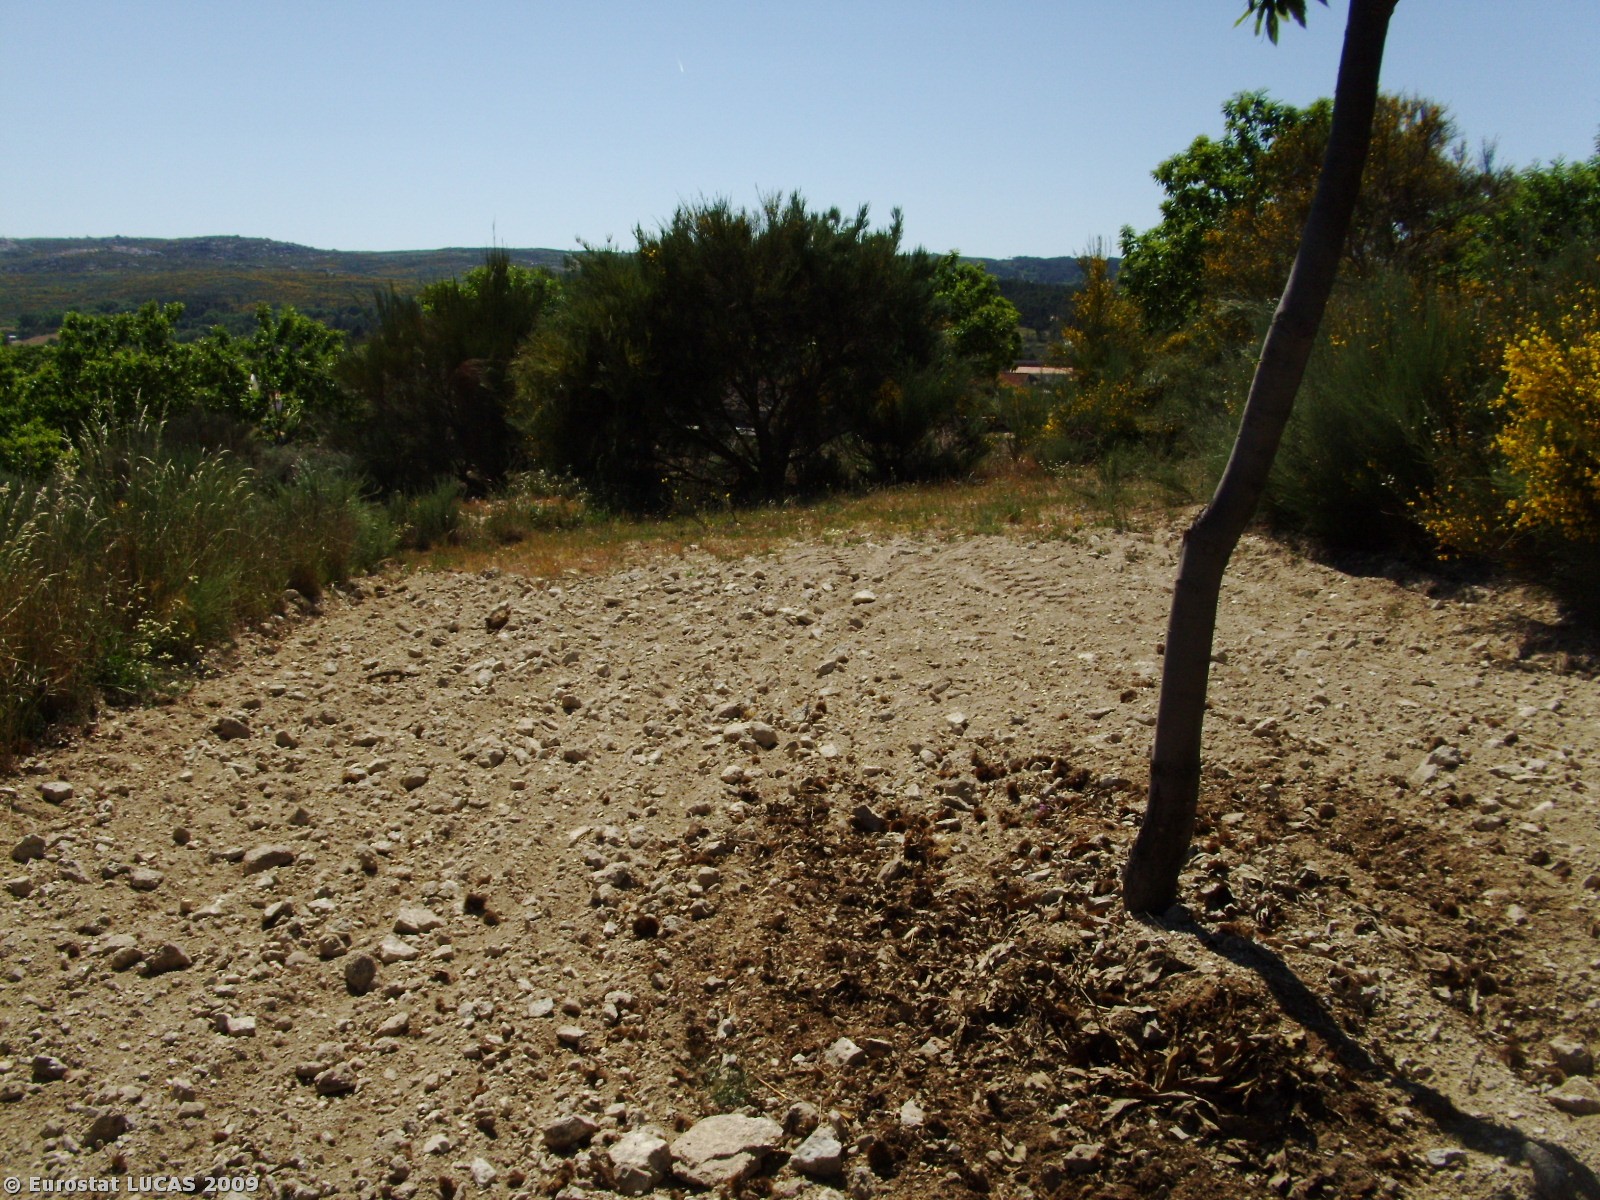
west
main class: Cropland
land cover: Nuts trees
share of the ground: 25 - 50 %
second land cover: Bare land
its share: 25 - 50 %
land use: Agriculture (excluding fallow land and kitchen gardens)
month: May
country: PT
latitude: 40.9032
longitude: -7.5579
